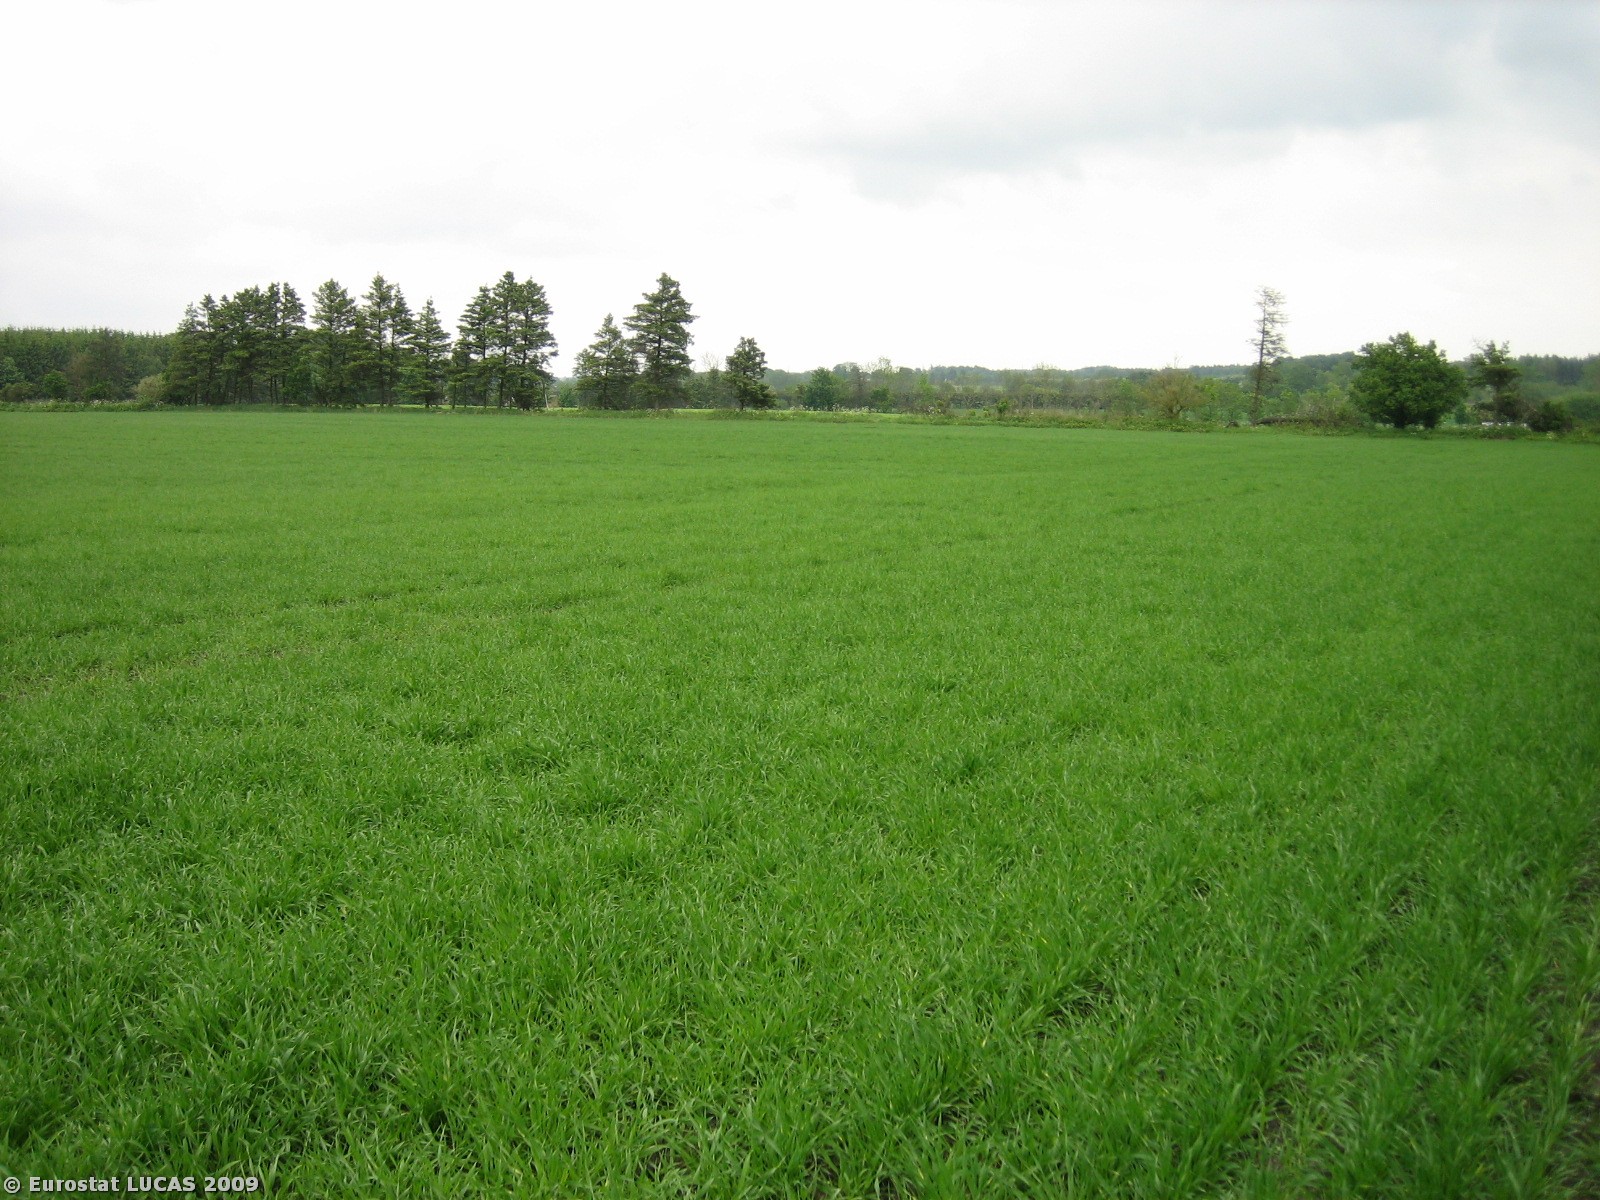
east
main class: Cropland
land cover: Barley
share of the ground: 50 - 75 %
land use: Agriculture (excluding fallow land and kitchen gardens)
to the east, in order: Barley; Grassland without tree/shrub cover; Dry pulses
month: May
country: DK
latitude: 55.7903
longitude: 9.2831
